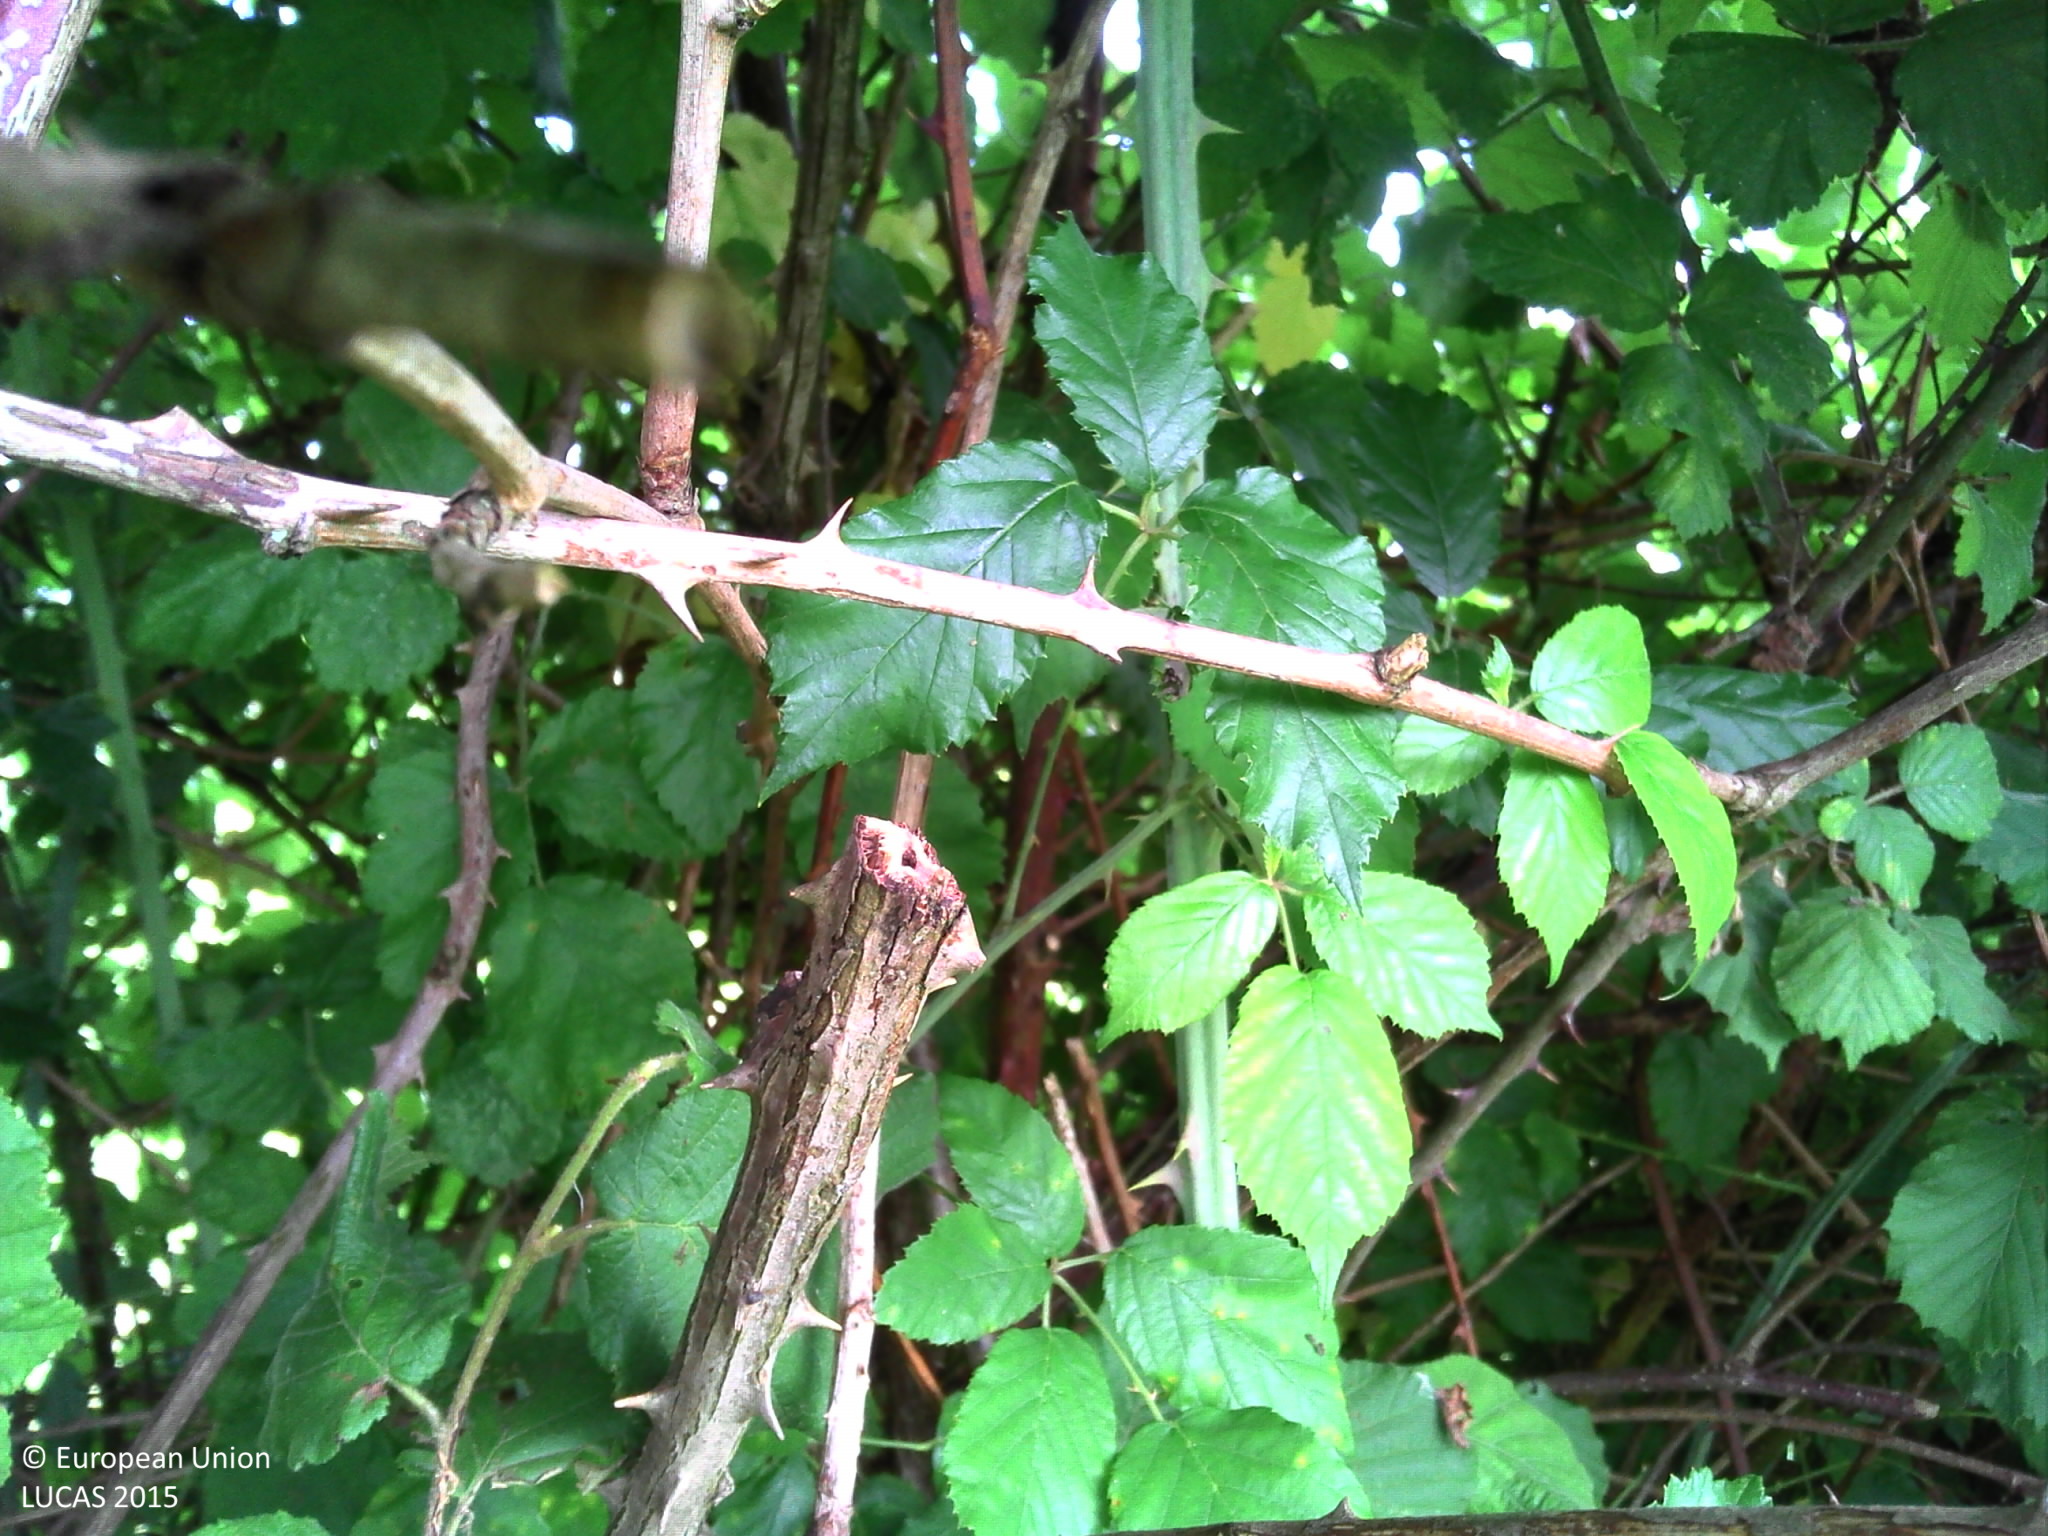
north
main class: Grassland
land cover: Grassland without tree/shrub cover
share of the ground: > 75 %
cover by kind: herbaceous plants 100 %
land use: Agriculture (excluding fallow land and kitchen gardens)
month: June
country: FR
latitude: 43.2030
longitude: -0.6294
